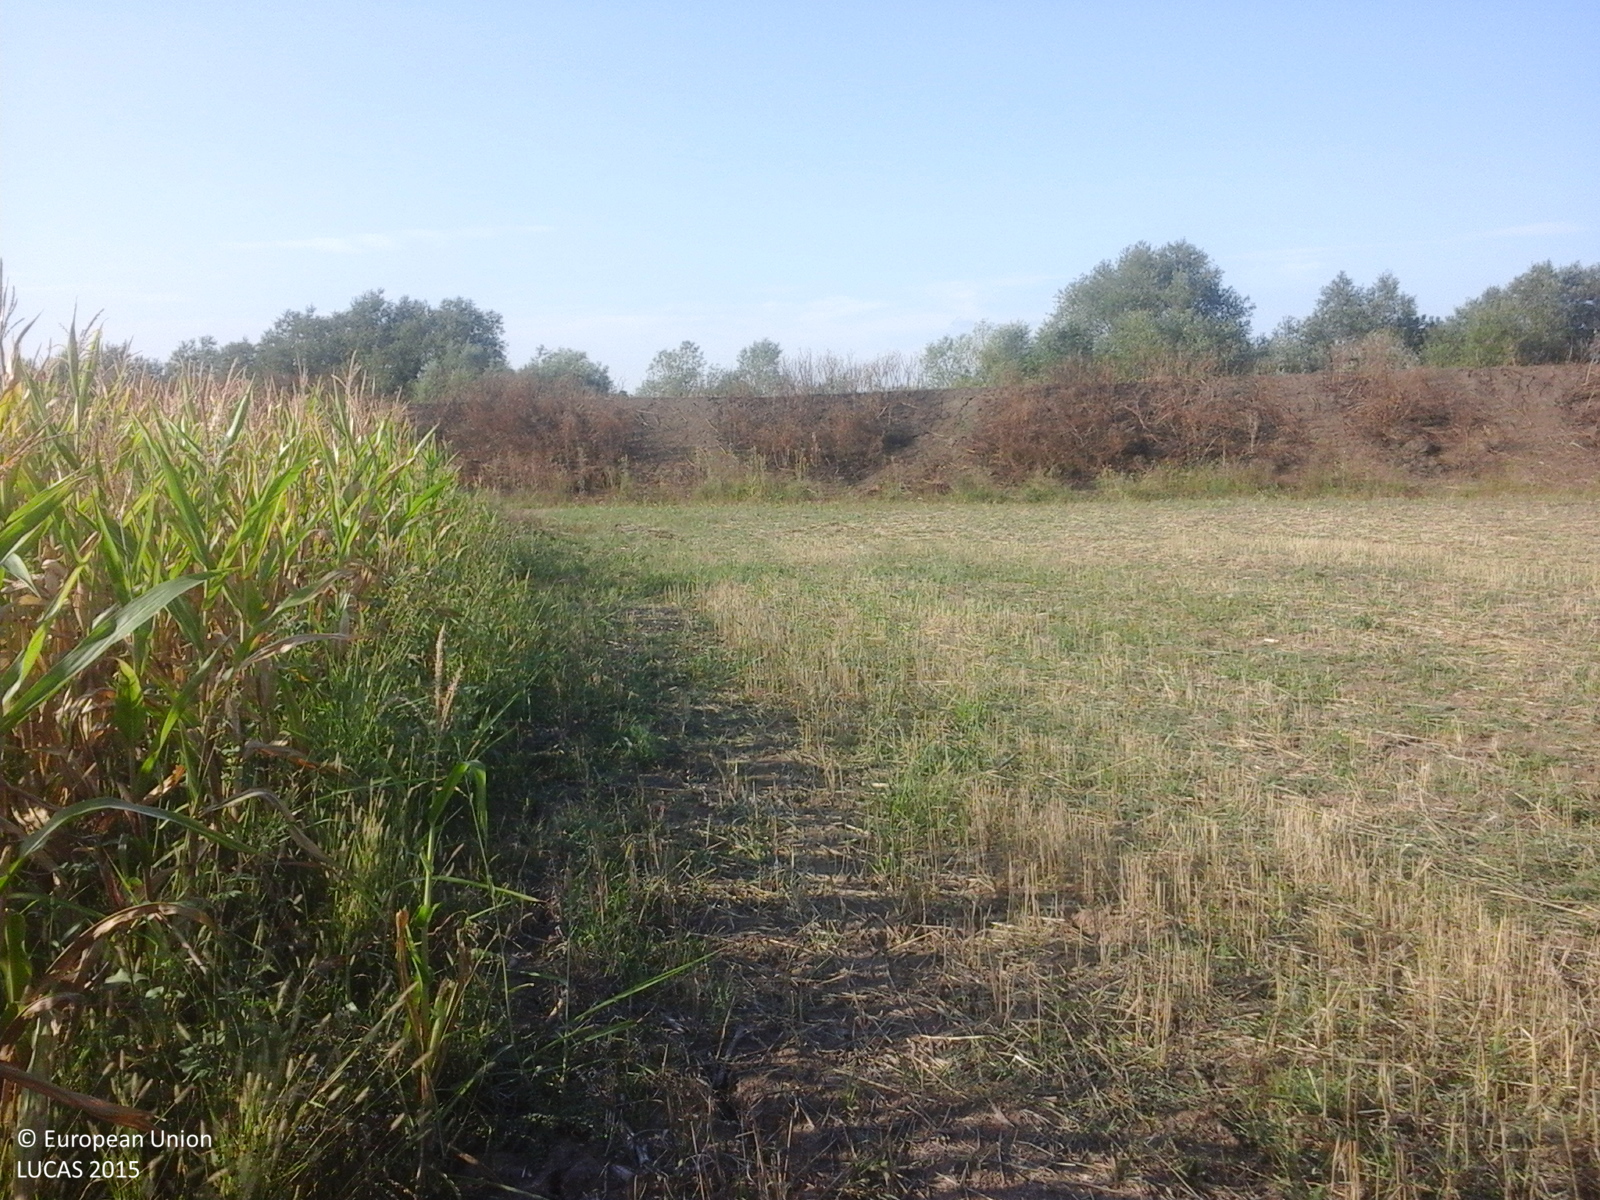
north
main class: Cropland
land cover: Maize
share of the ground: > 75 %
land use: Agriculture (excluding fallow land and kitchen gardens)
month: August
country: RO
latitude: 45.4311
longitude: 21.3939
